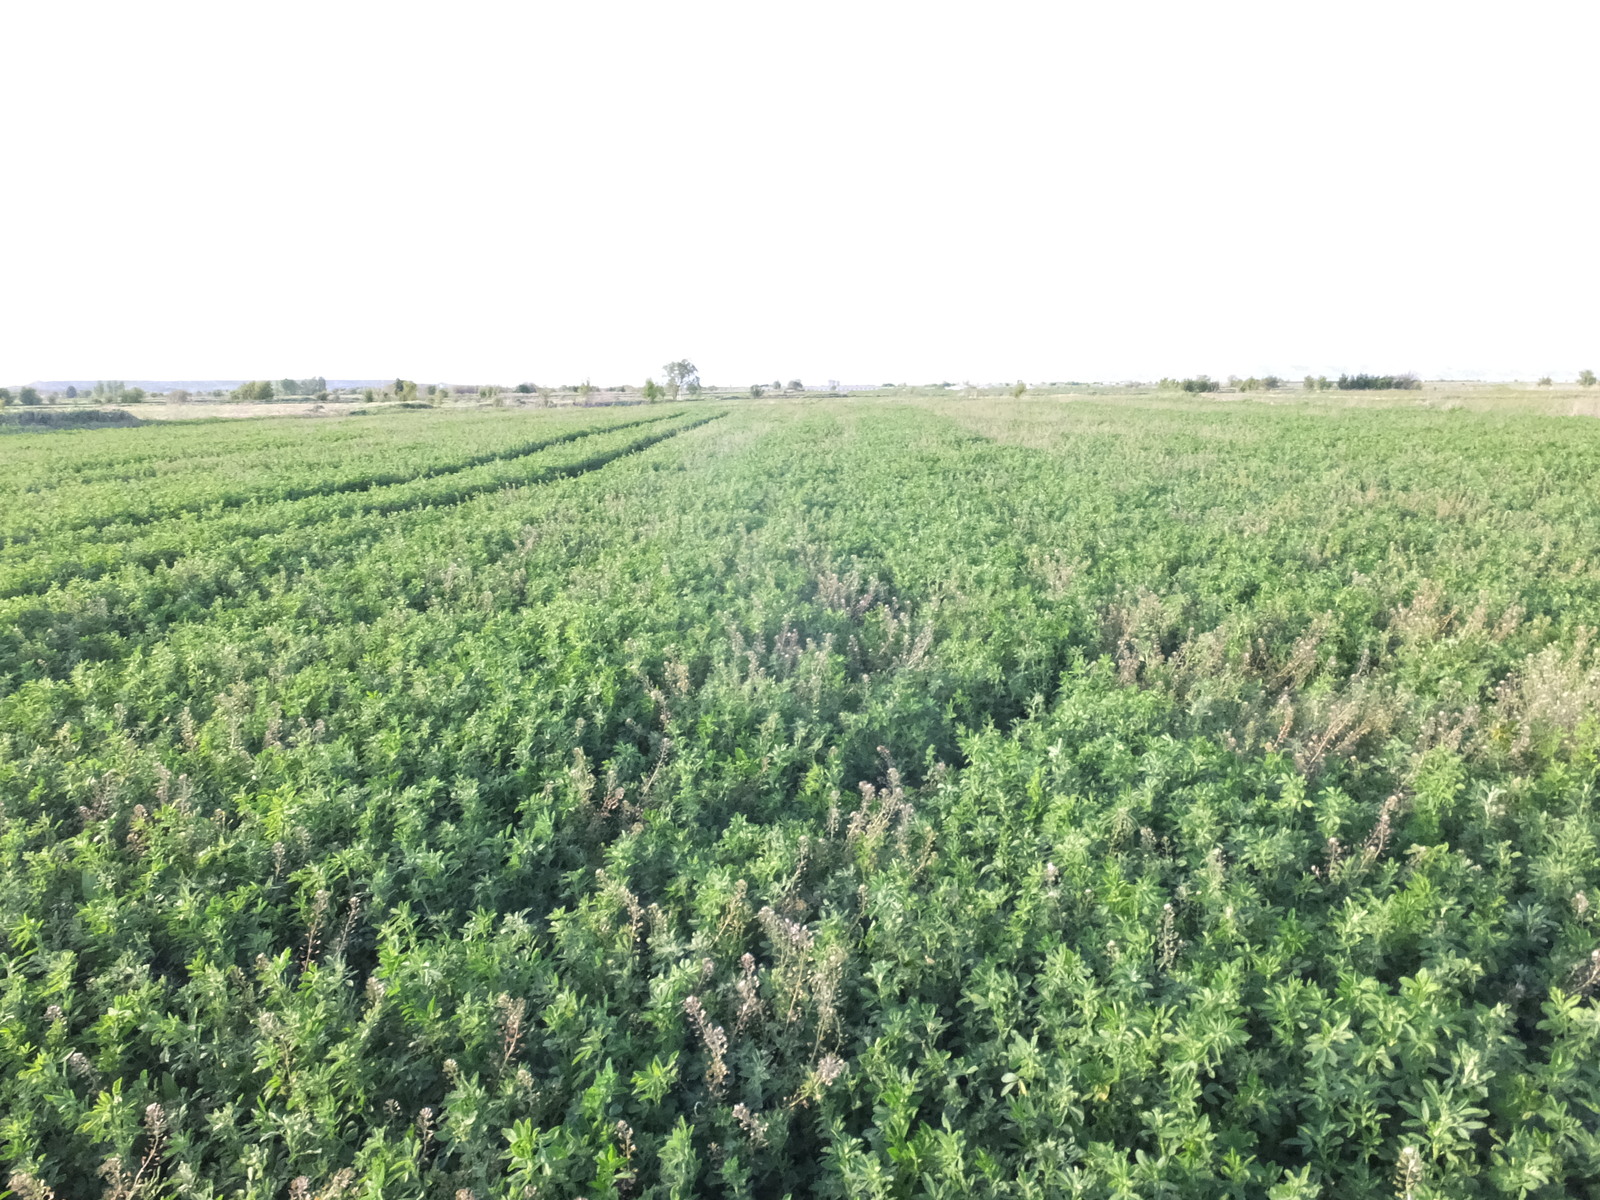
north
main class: Cropland
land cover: Lucerne
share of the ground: > 75 %
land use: Agriculture (excluding fallow land and kitchen gardens)
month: April
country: ES
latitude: 41.7966
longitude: -0.3328
